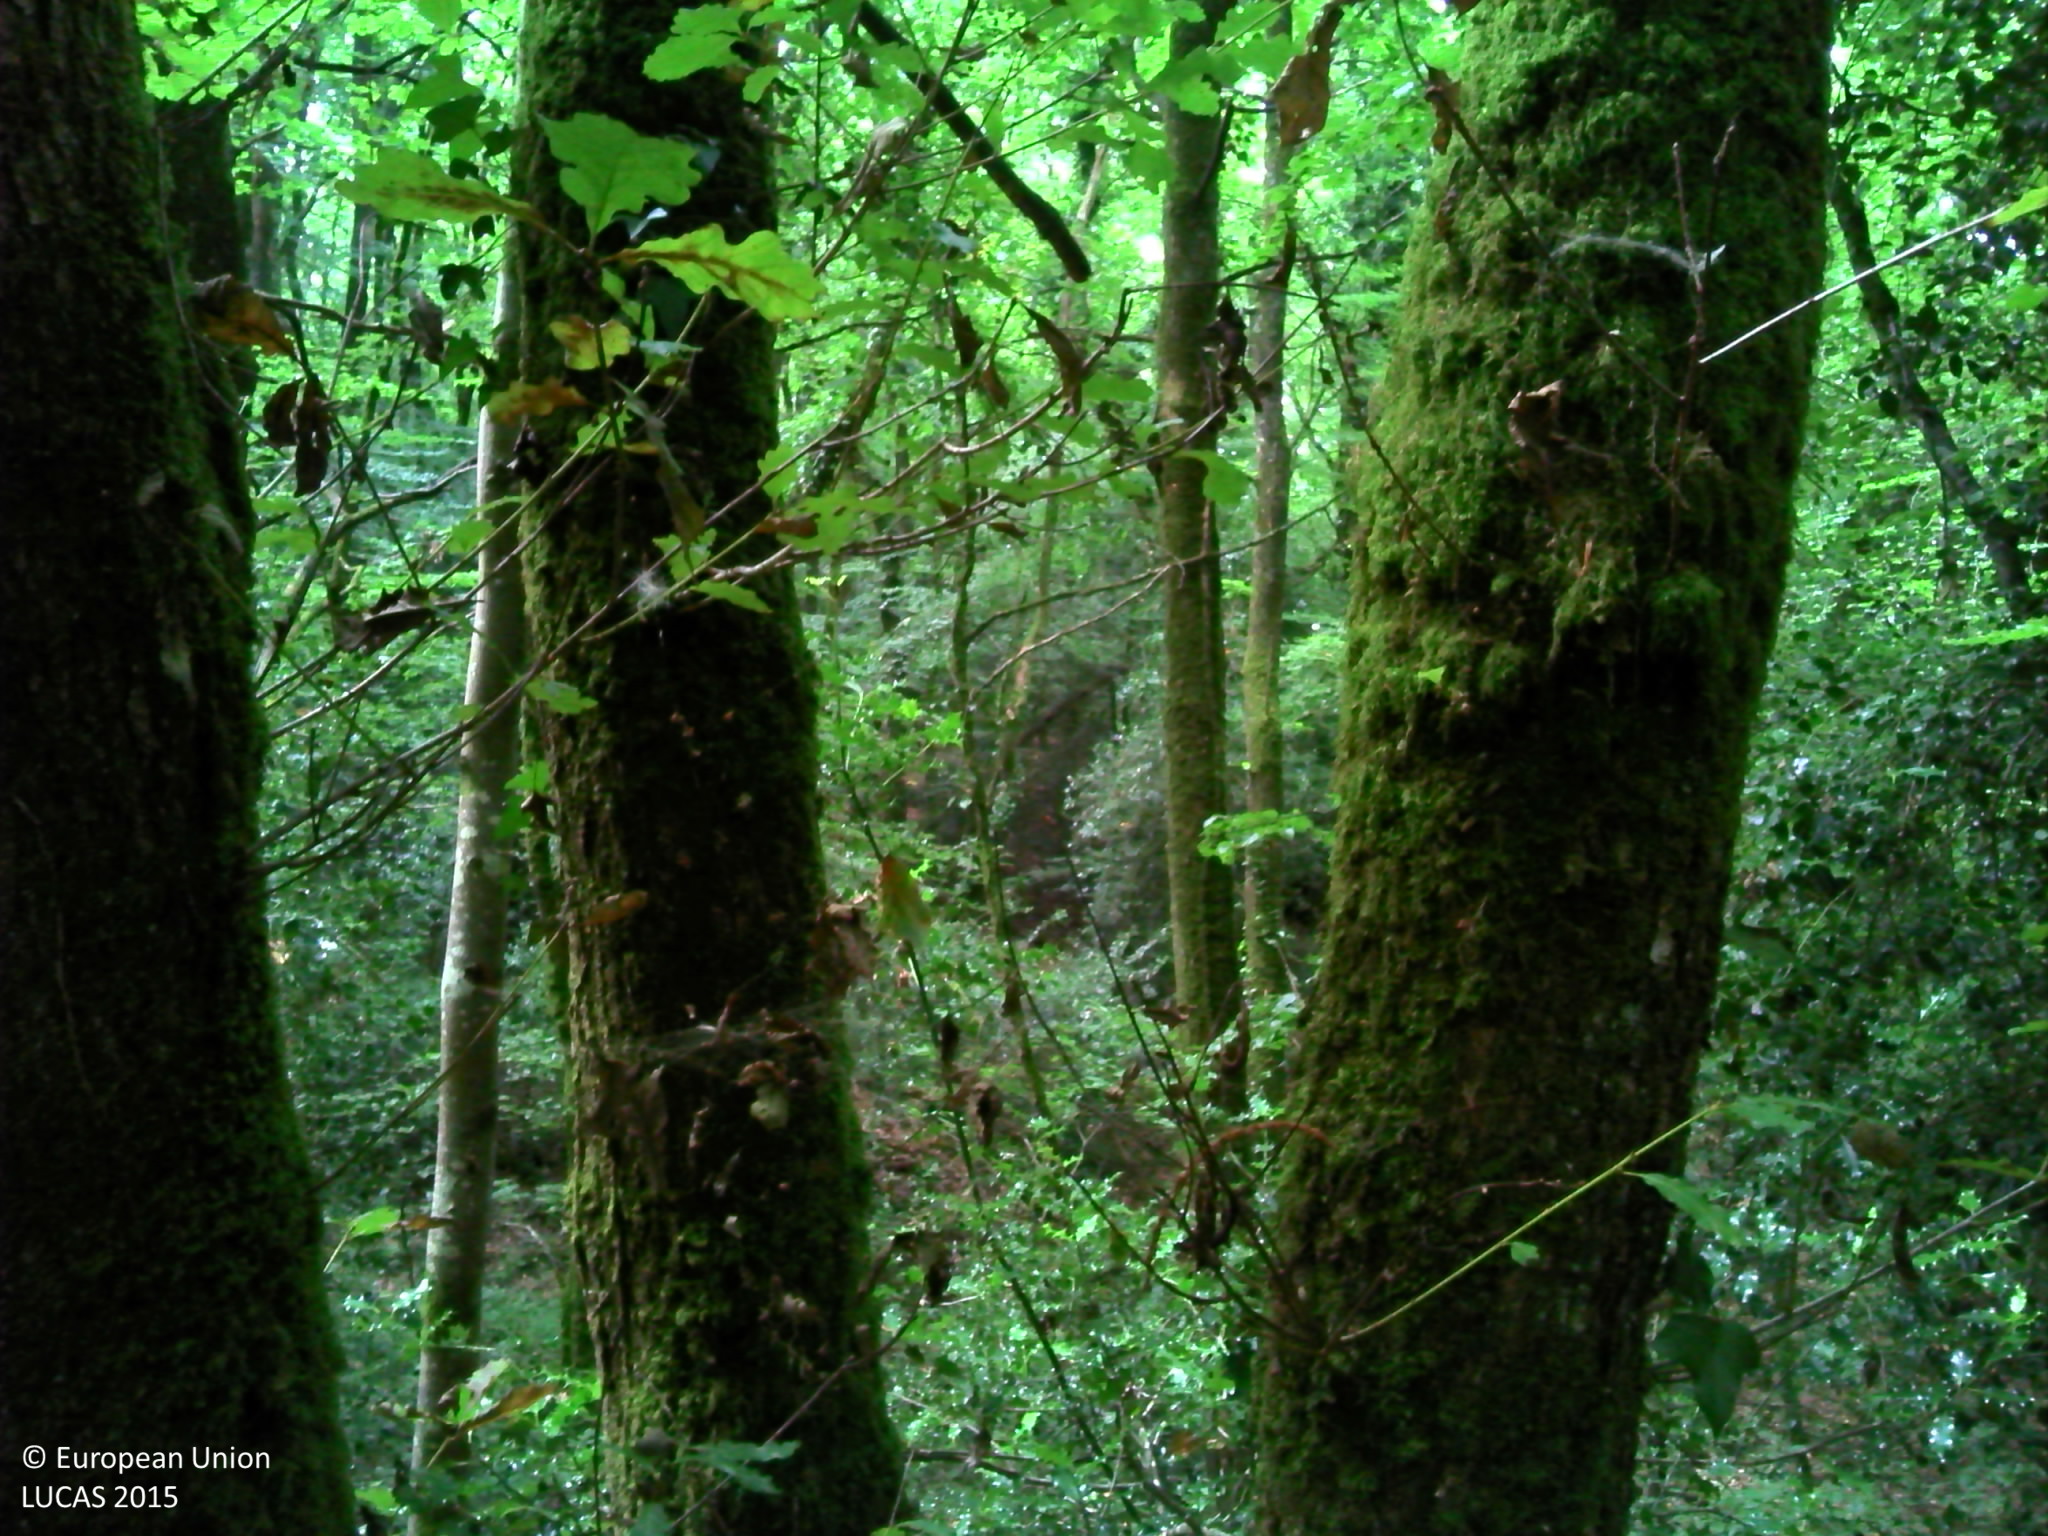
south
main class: Woodland
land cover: Broadleaved woodland
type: acidophilous oak and oak-birch forest
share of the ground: > 75 %
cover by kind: broadleaved forest trees 80 %, shrubs 10 %, herbaceous plants 10 %
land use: Forestry
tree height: > 5 m
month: August
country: FR
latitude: 48.3499
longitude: -3.3949
